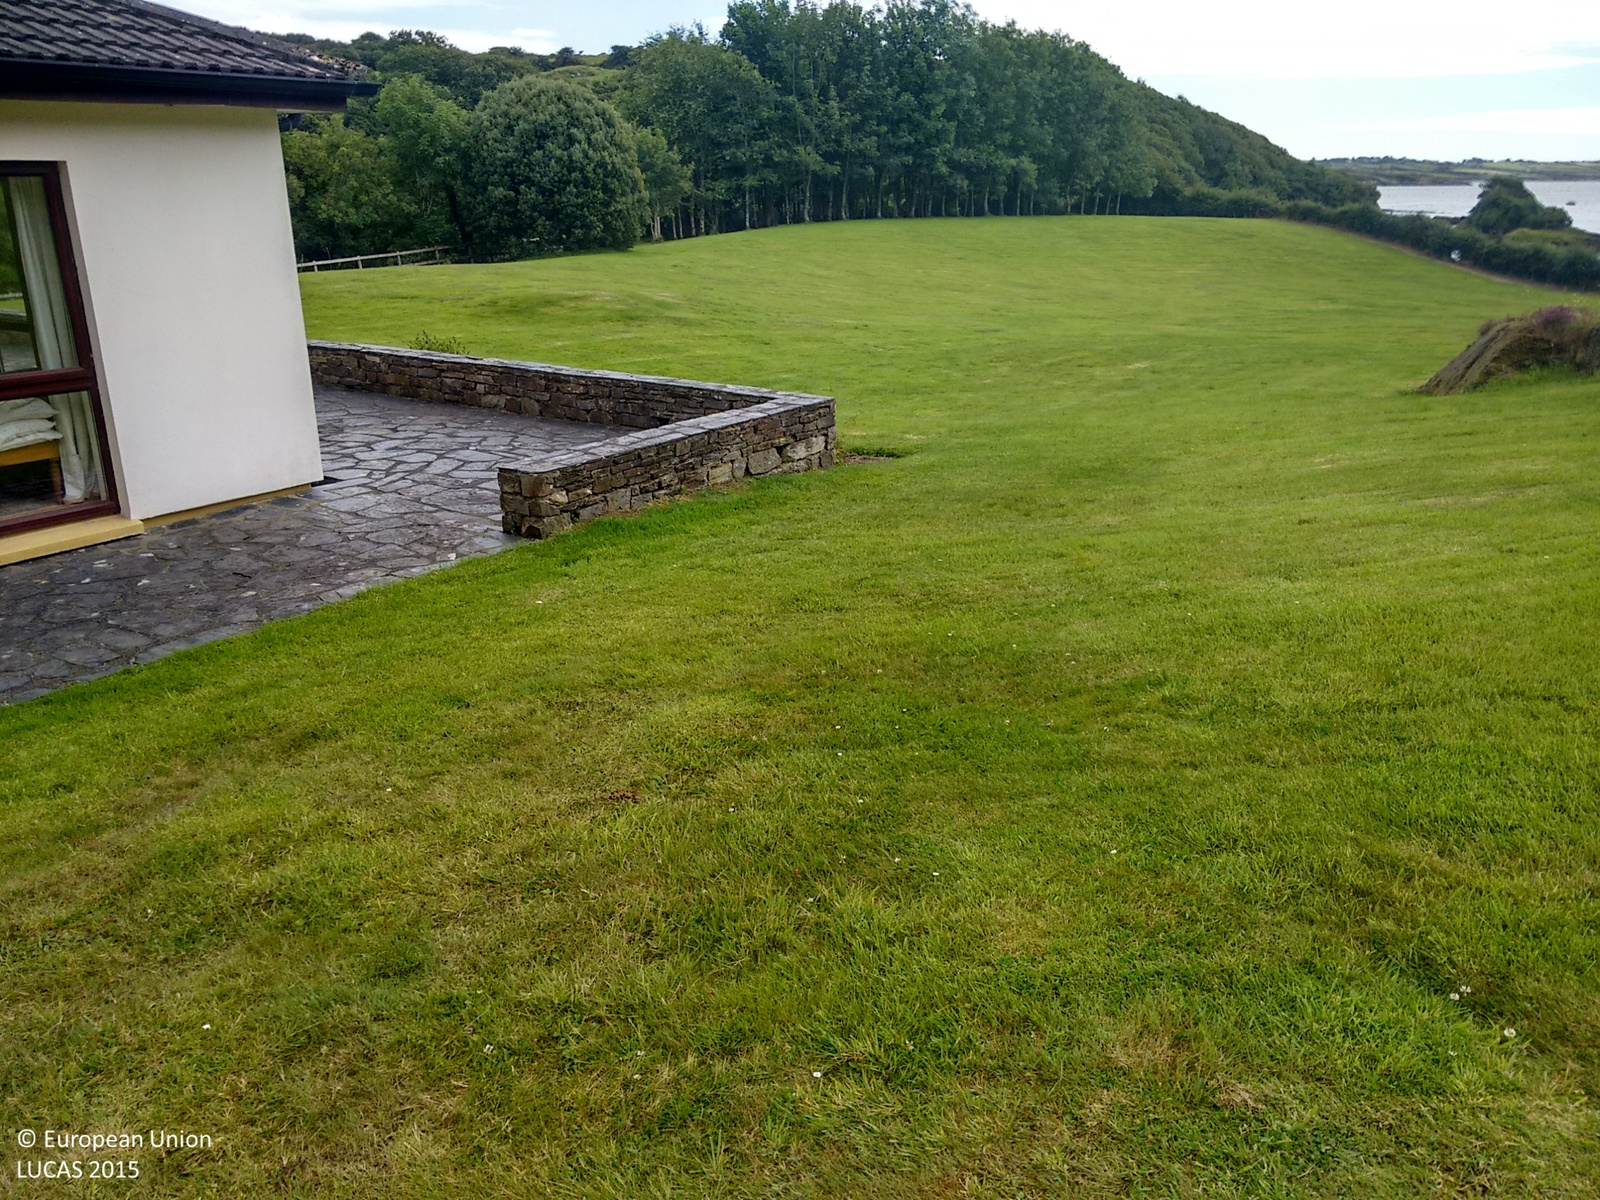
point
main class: Grassland
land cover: Grassland without tree/shrub cover
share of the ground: > 75 %
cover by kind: herbaceous plants 80 %
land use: Residential
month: July
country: IE
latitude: 51.5510
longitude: -9.3947
